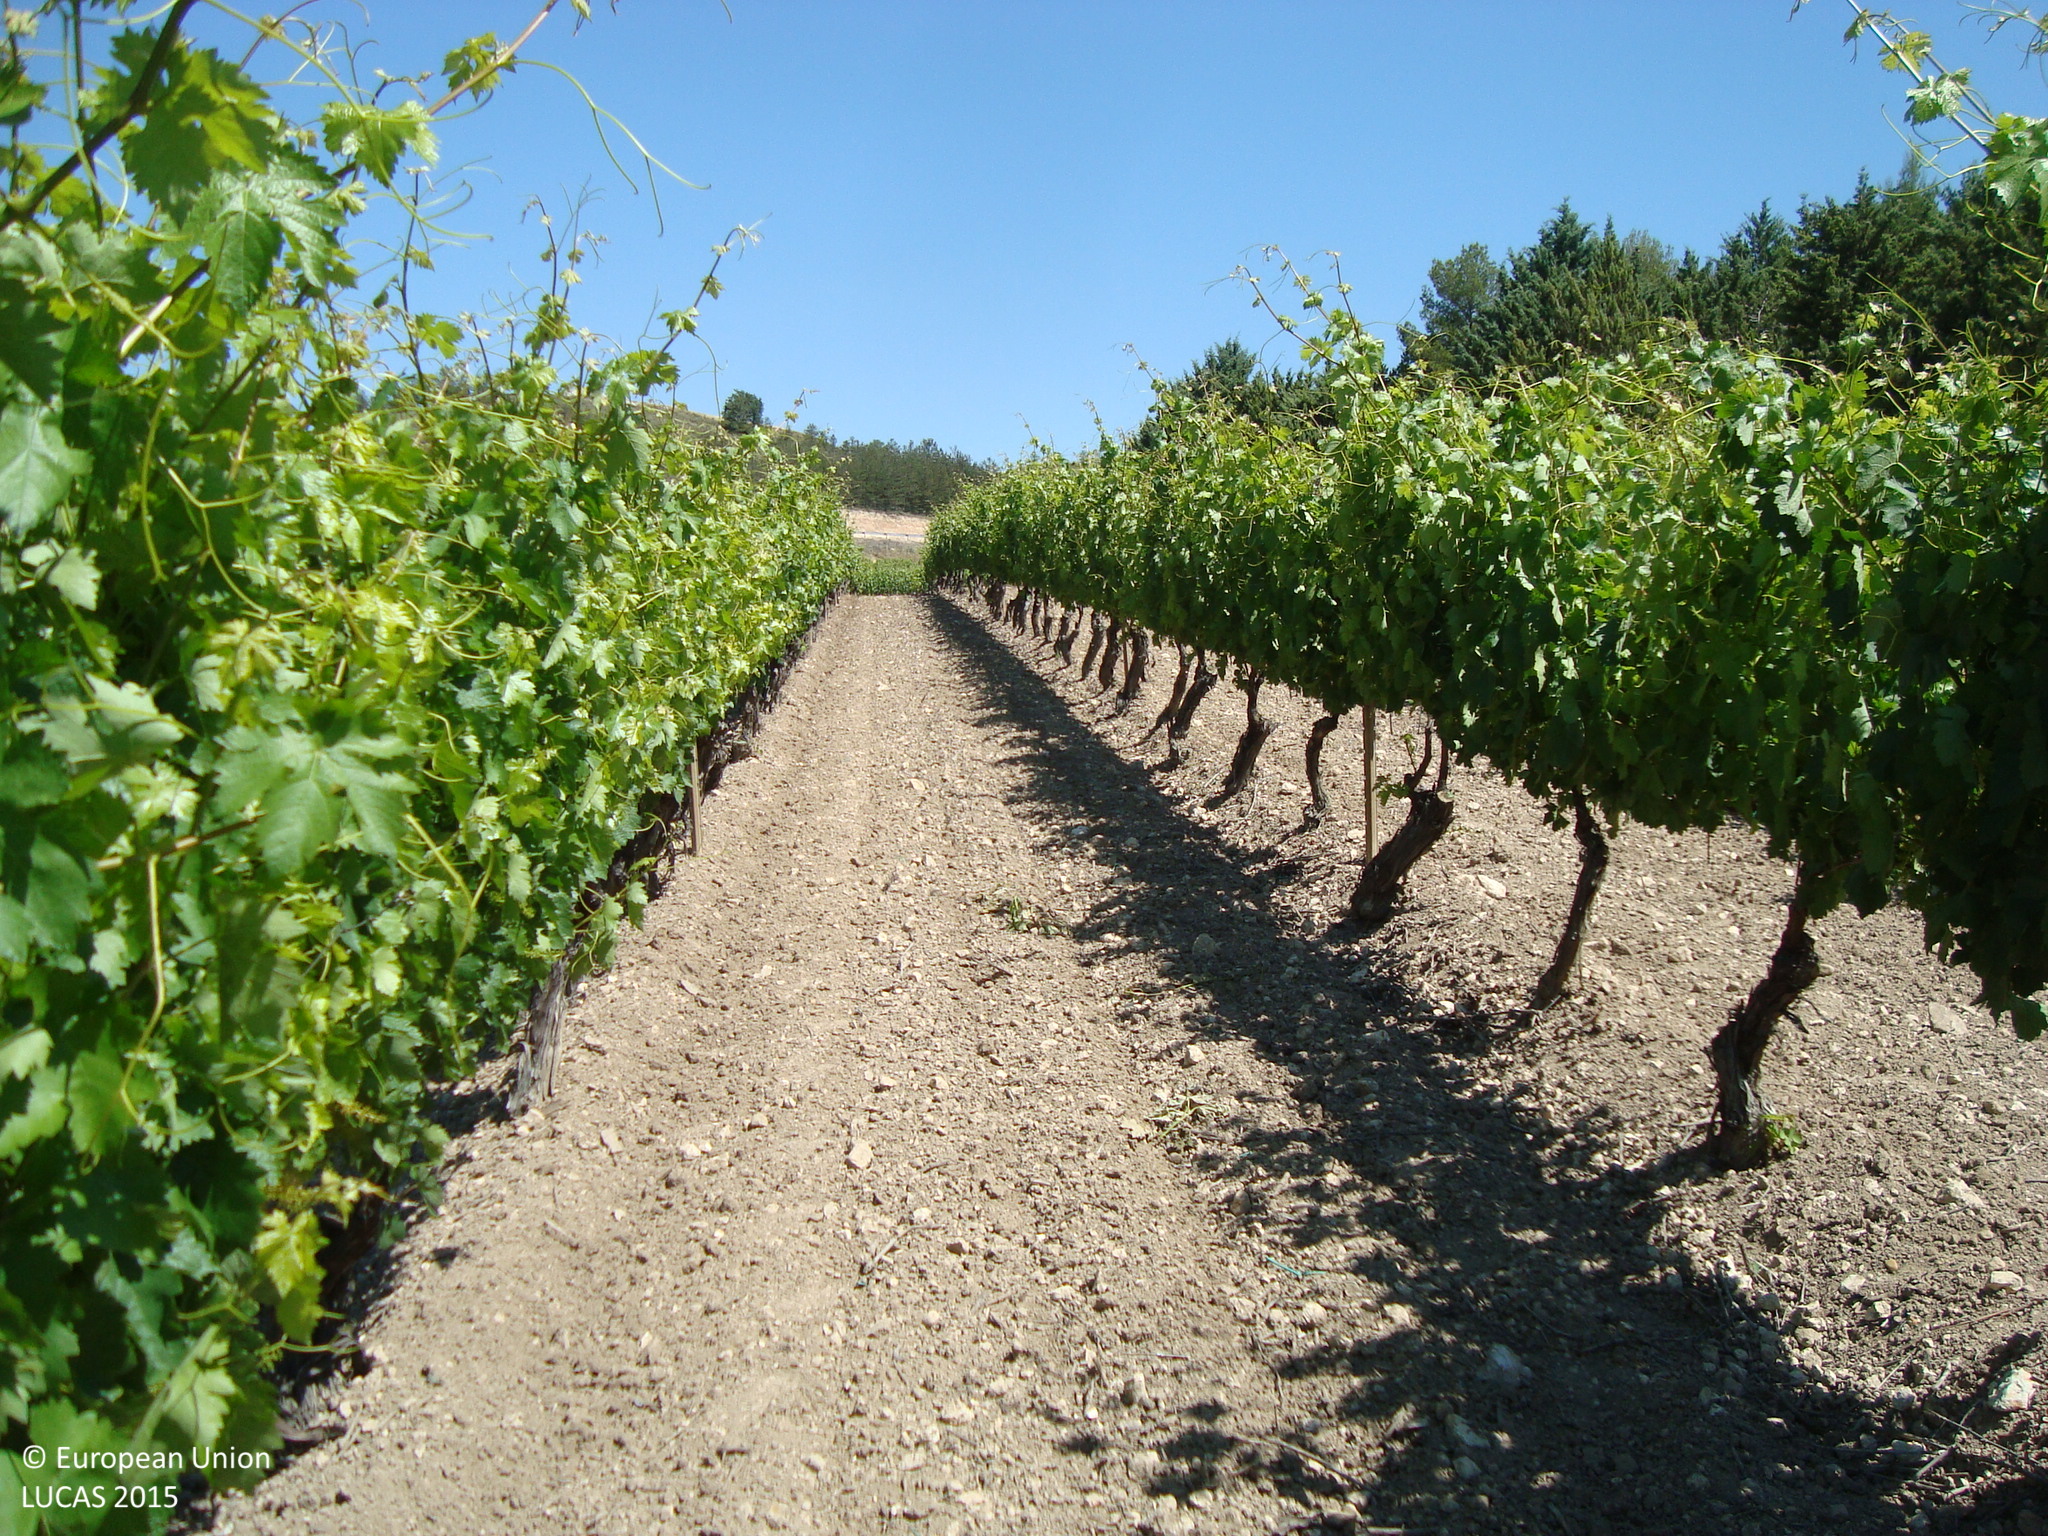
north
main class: Cropland
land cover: Vineyards
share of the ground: 25 - 50 %
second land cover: Other bare soil
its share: > 75 %
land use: Agriculture (excluding fallow land and kitchen gardens)
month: June
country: ES
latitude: 41.7943
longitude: -3.8110
